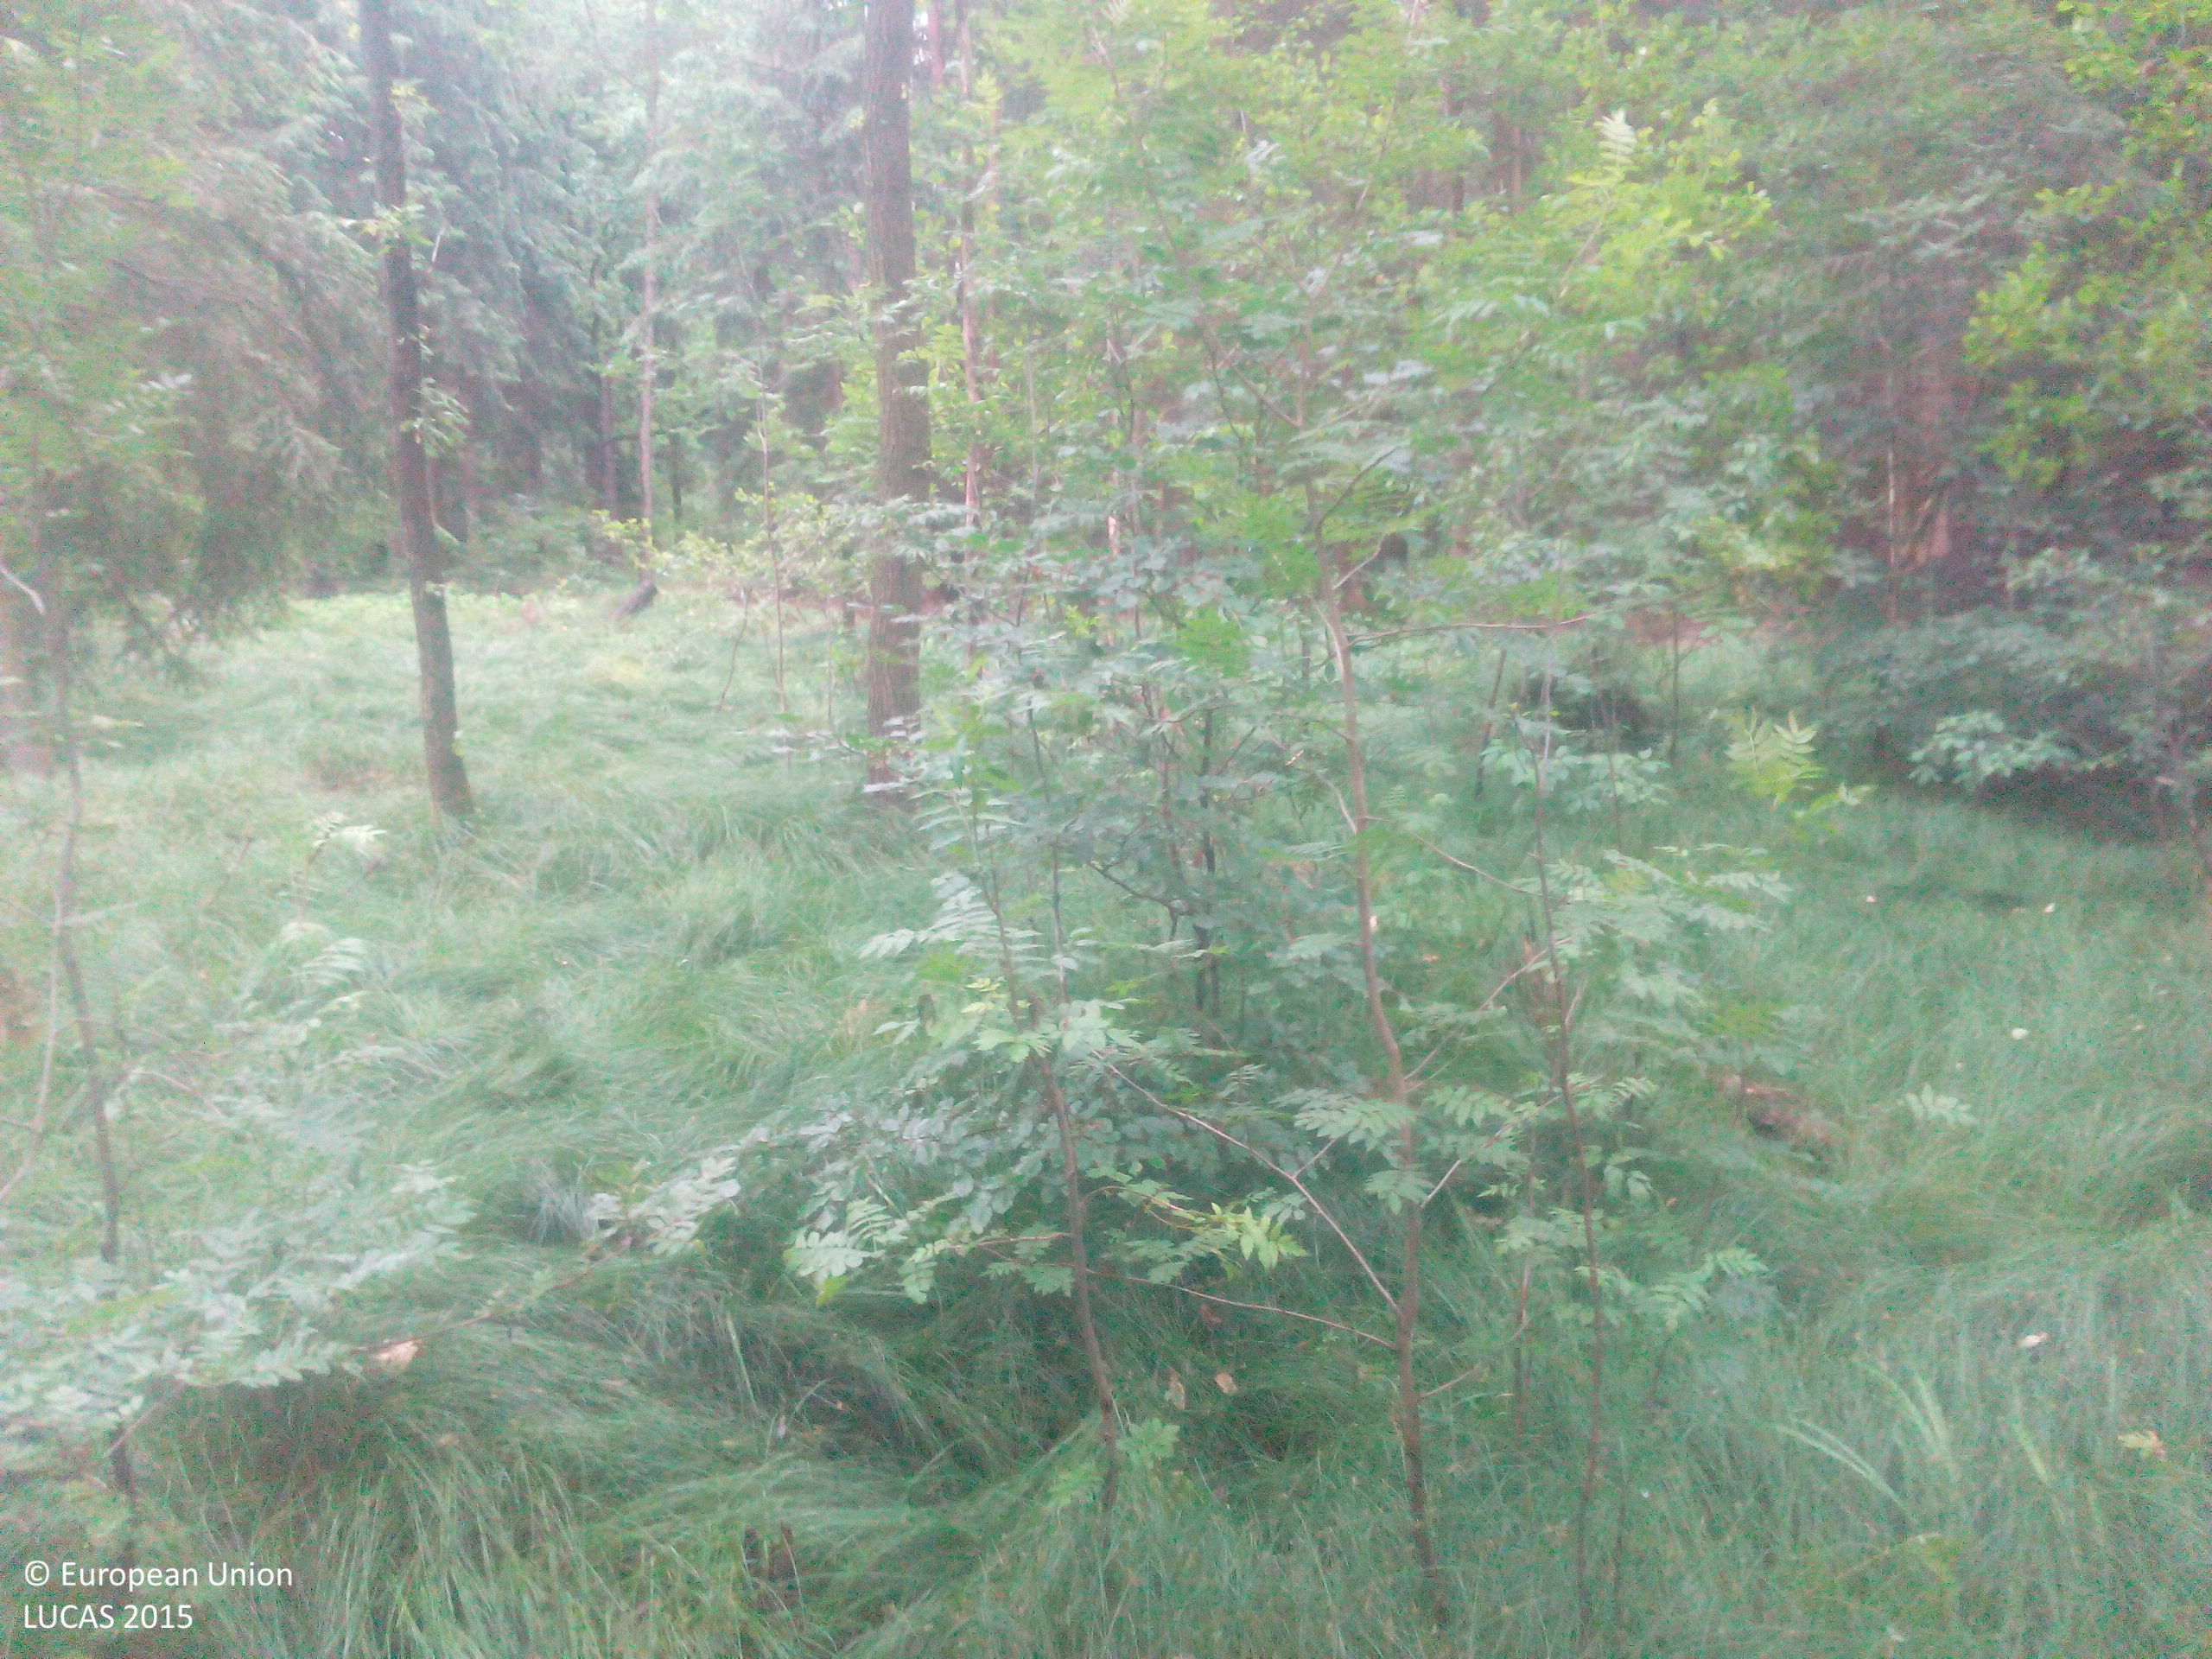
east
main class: Woodland
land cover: Spruce dominated mixed woodland
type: hemiboreal forest and nemoral coniferous forest and mixed broadleaved-coniferous forest
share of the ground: > 75 %
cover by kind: broadleaved forest trees 60 %, coniferous forest trees 25 %, herbaceous plants 15 %
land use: Forestry
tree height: > 5 m
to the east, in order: Spruce dominated mixed woodland; Spruce dominated coniferous woodland; Other mixed woodland; Tracks; Pine dominated mixed woodland; Spruce dominated mixed woodland; Paved roads, cycling and walking lanes; Spruce dominated coniferous woodland
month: June
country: DE
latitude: 51.0868
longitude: 13.9841
